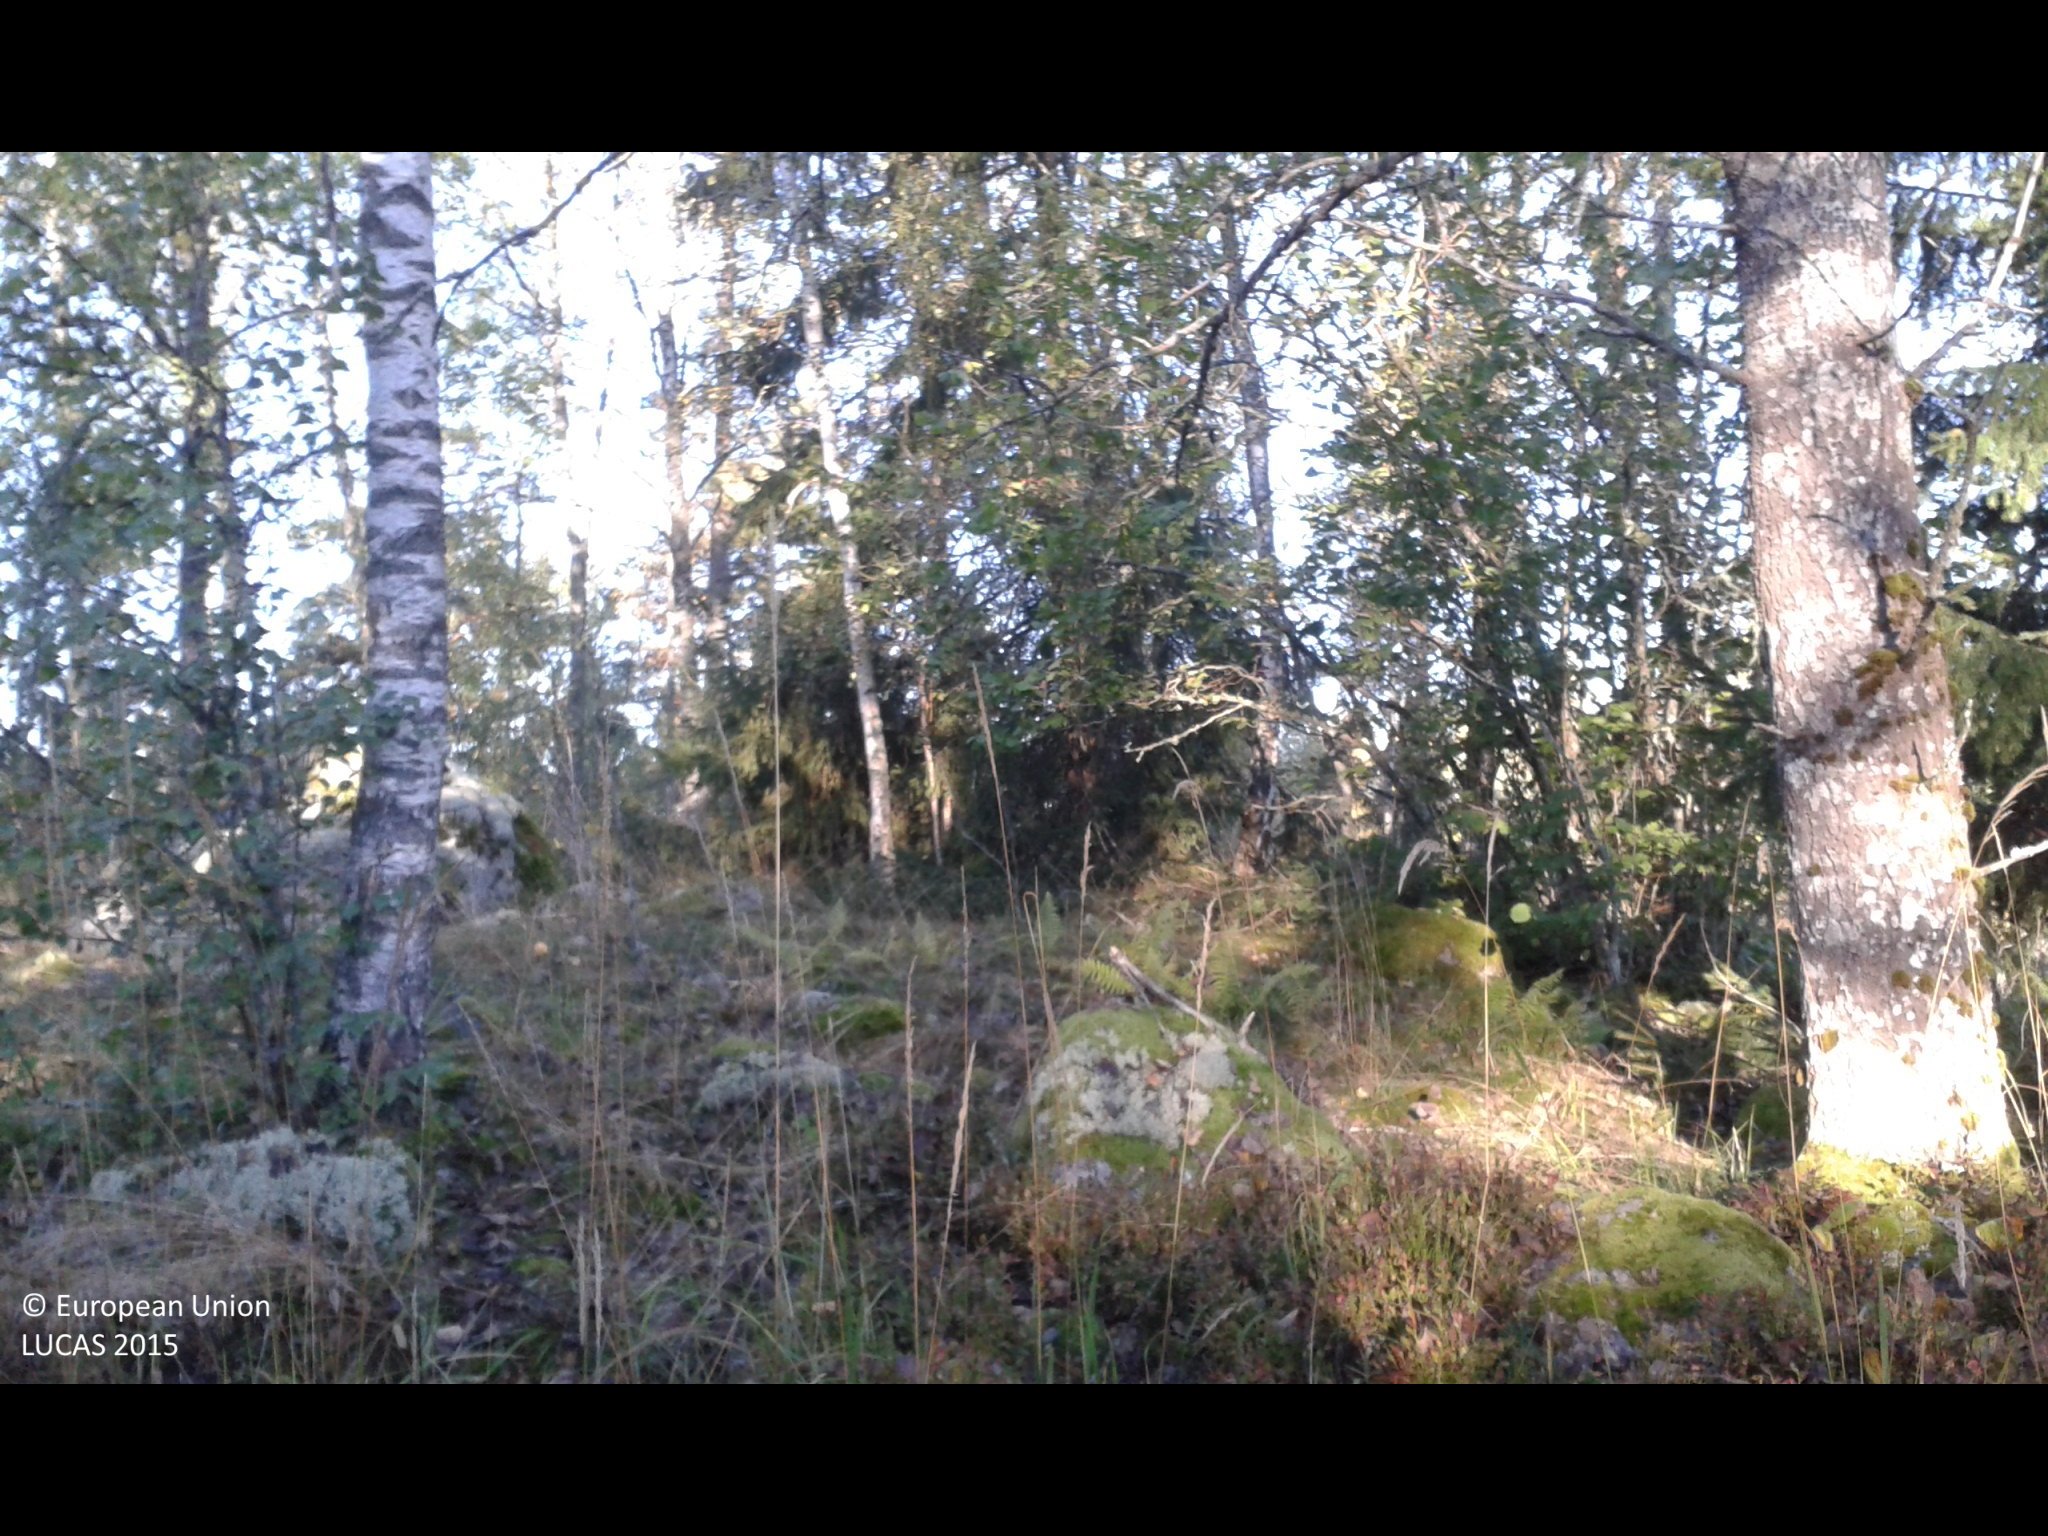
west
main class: Woodland
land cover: Spruce dominated mixed woodland
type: hemiboreal forest and nemoral coniferous forest and mixed broadleaved-coniferous forest
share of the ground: > 75 %
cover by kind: broadleaved forest trees 60 %, coniferous forest trees 20 %, shrubs 10 %, lichens and mosses 10 %
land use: Forestry
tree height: > 5 m
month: September
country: SE
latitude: 59.0578
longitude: 17.5126
